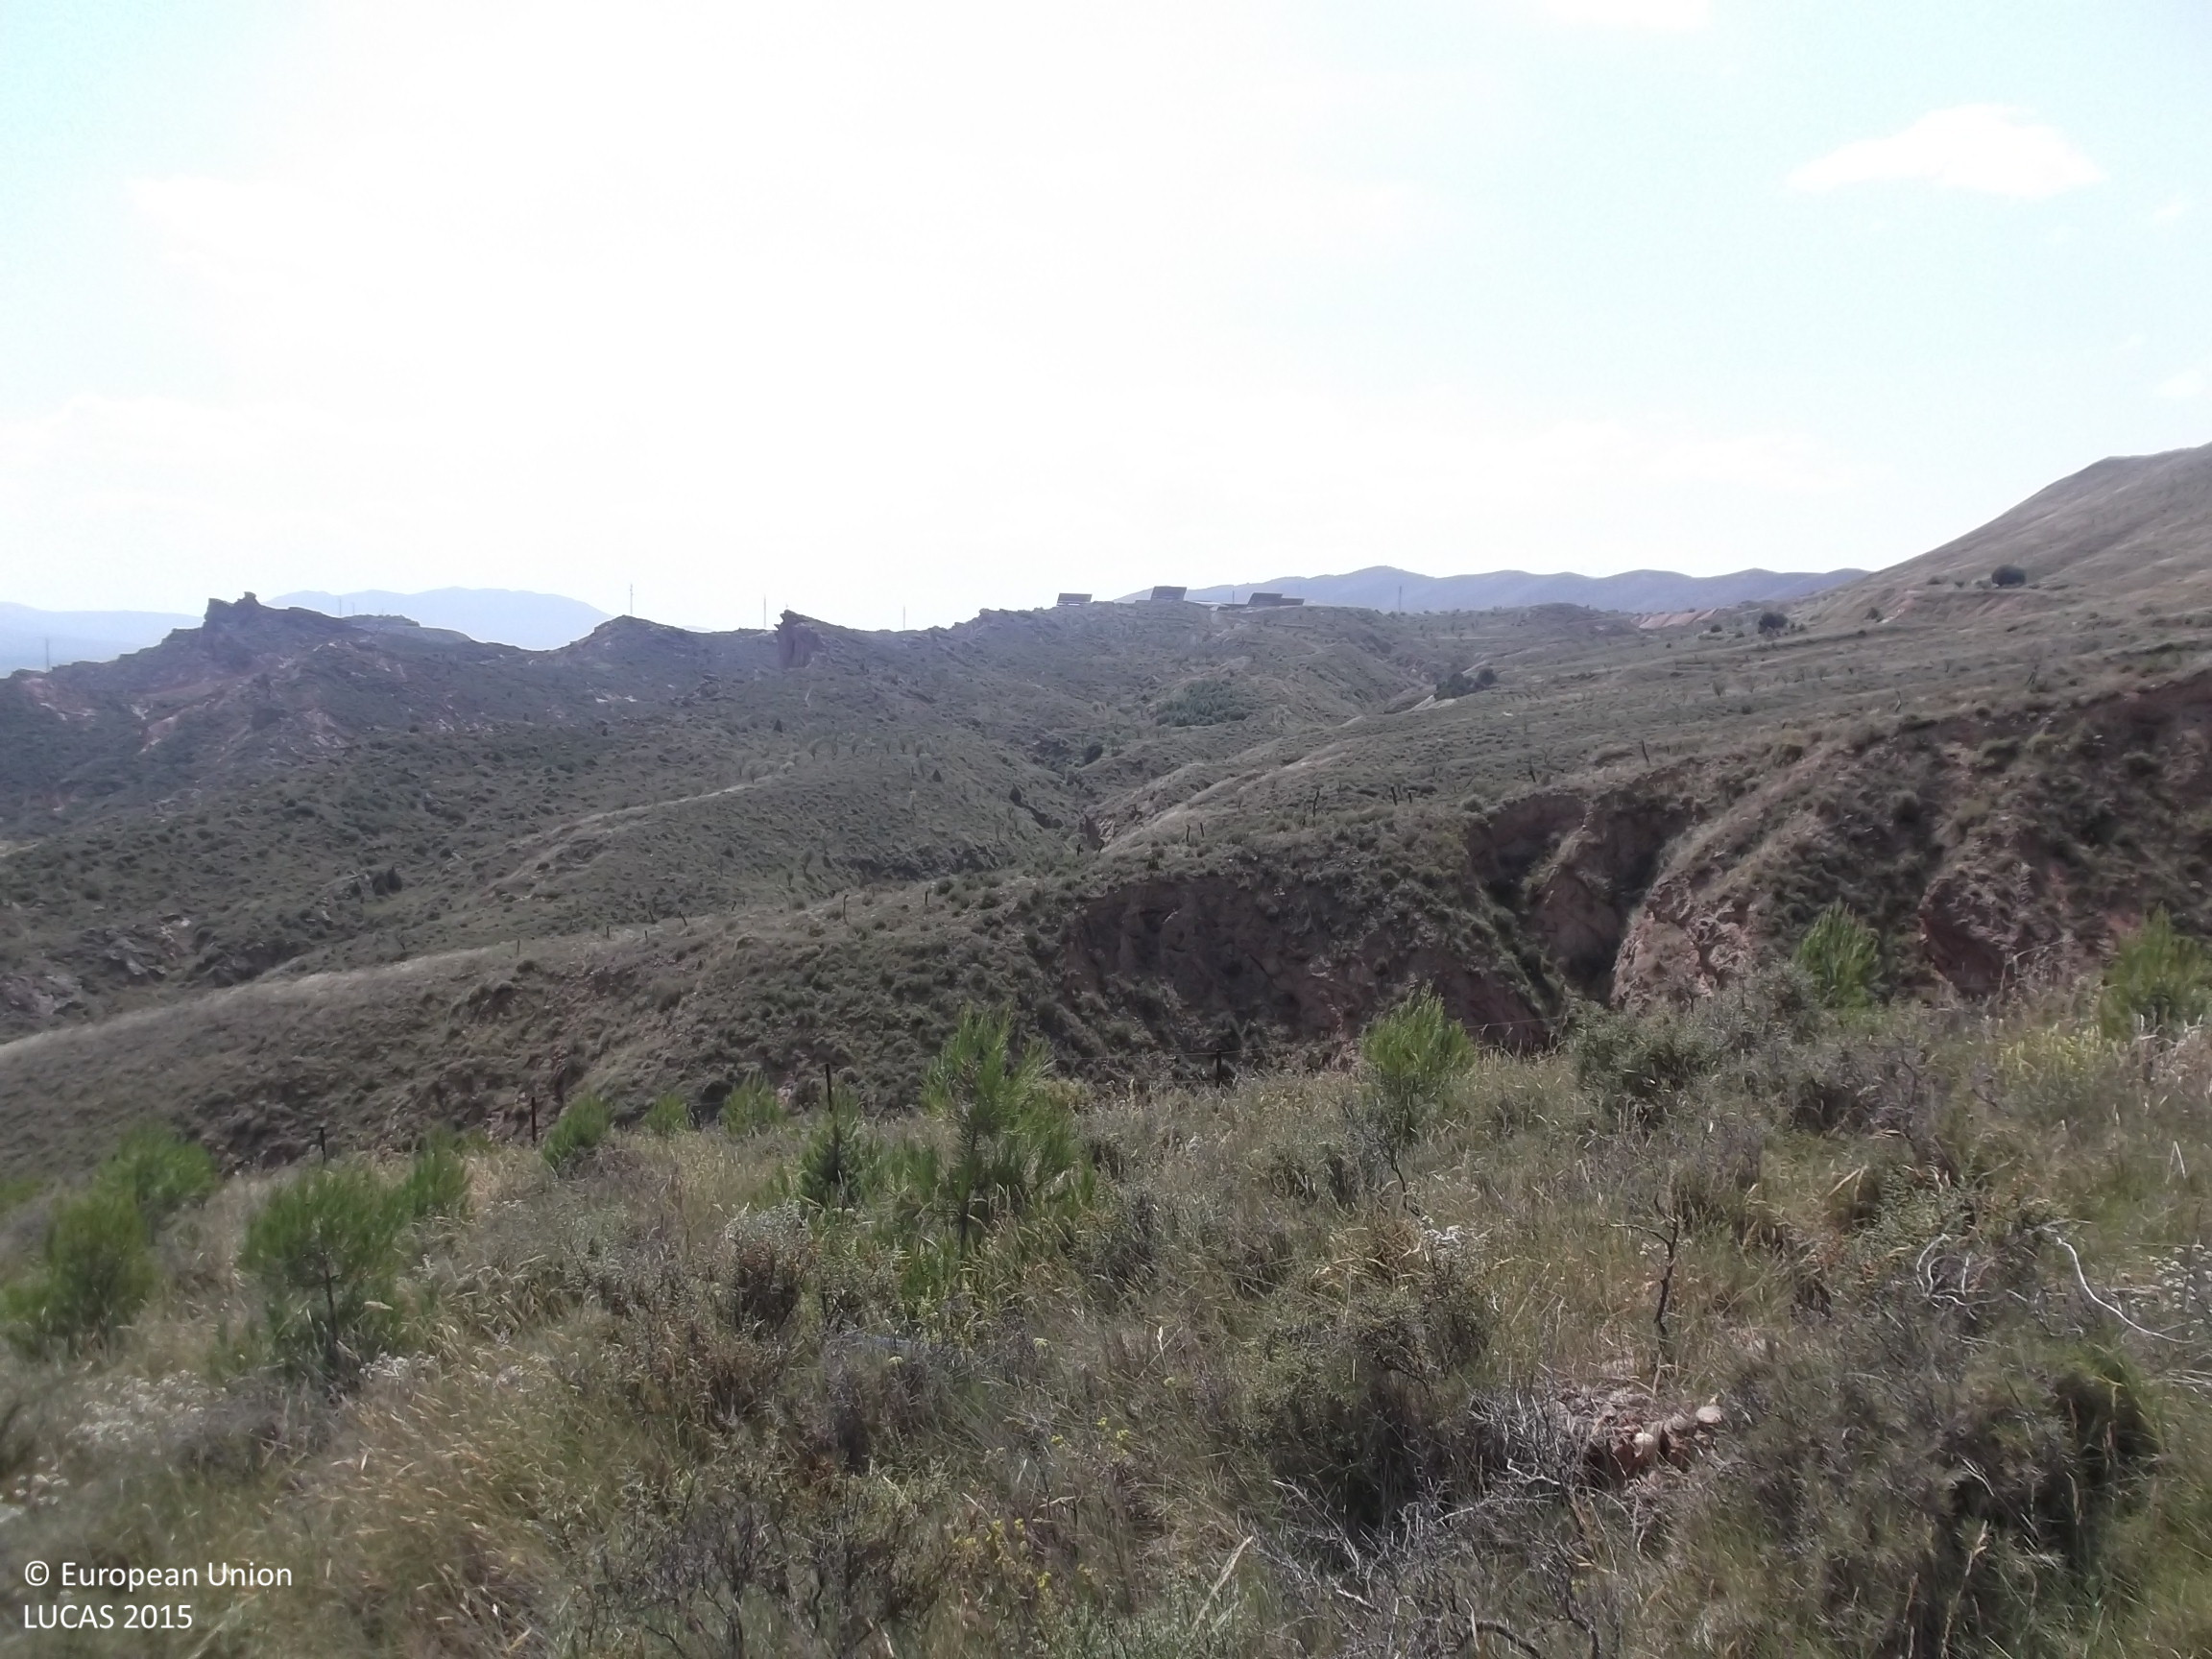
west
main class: Woodland
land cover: Pine dominated coniferous woodland
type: coniferous forest of the mediterranean region
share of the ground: 10 - 25 %
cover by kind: shrubs 70 %, coniferous forest trees 10 %, herbaceous plants 10 %, unconsolidated bare surface 10 %
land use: Forestry
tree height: < 5 m
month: June
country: ES
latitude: 42.2393
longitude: -2.0718
